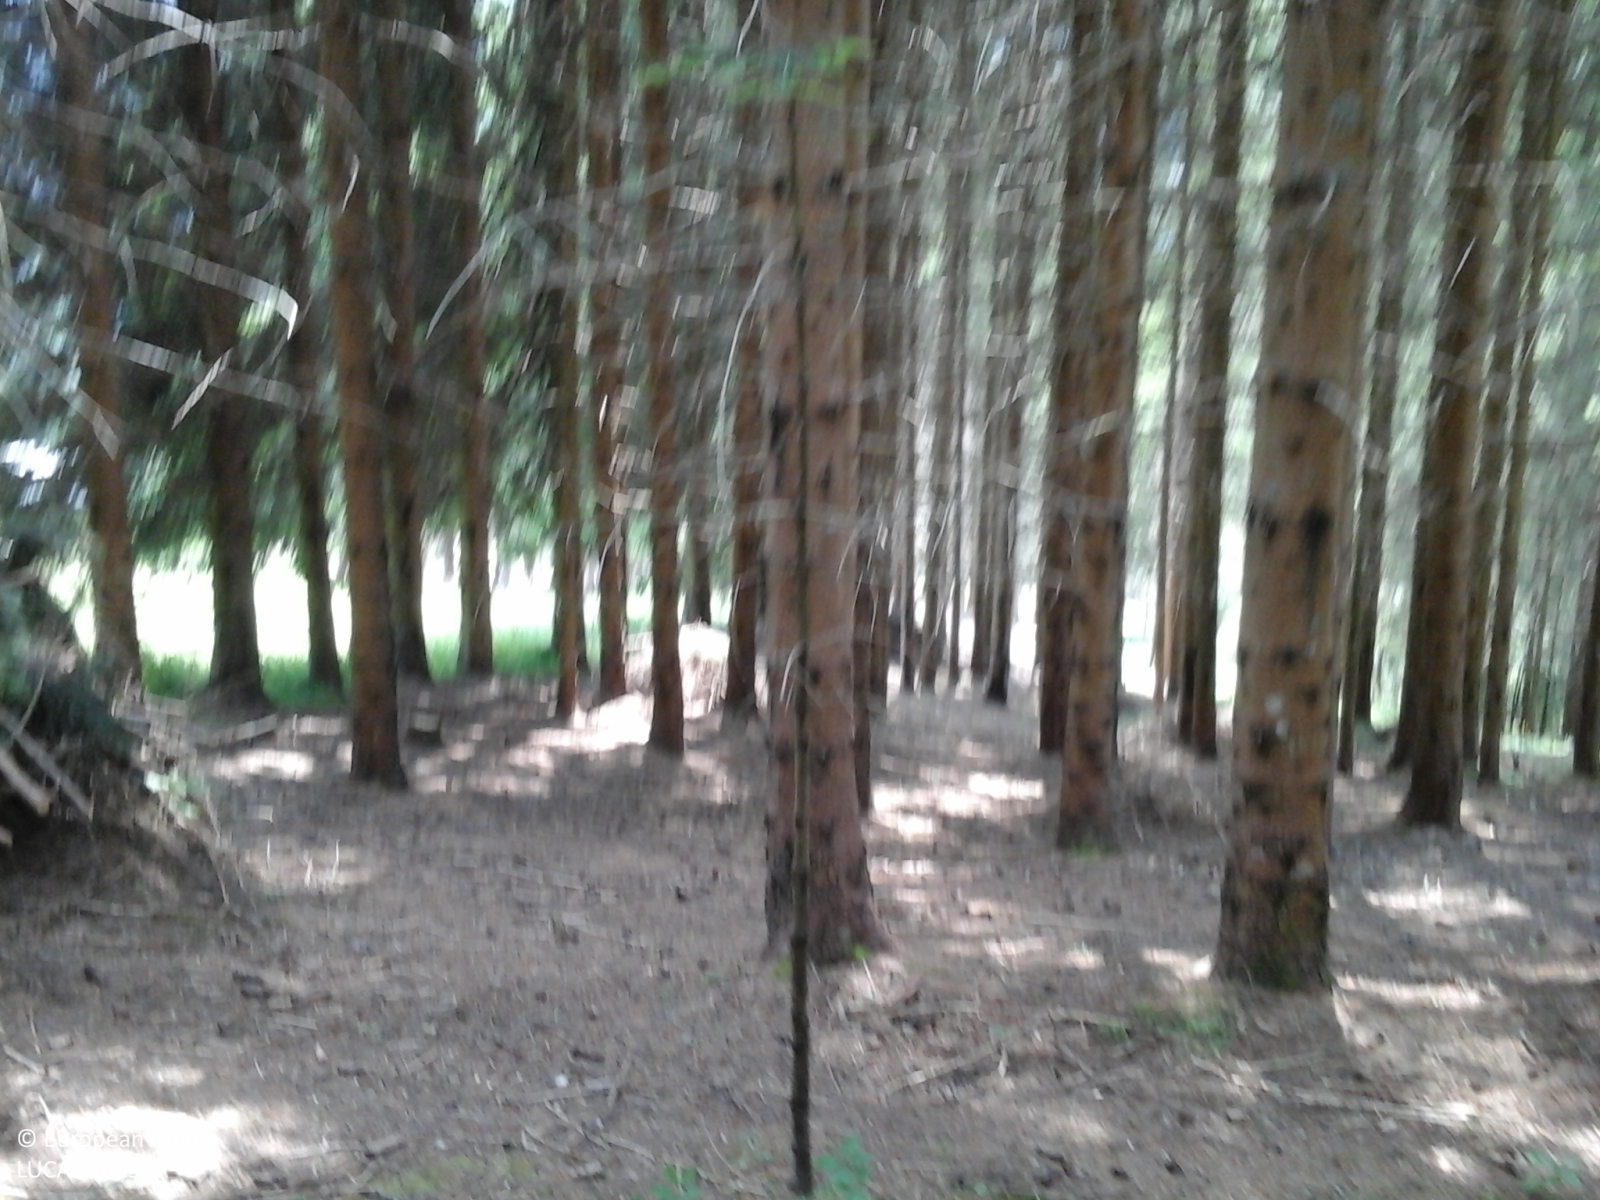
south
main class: Woodland
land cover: Spruce dominated coniferous woodland
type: alpine coniferous forest
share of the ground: > 75 %
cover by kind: coniferous forest trees 95 %, herbaceous plants 5 %
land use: Forestry
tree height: > 5 m
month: June
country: IT
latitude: 46.5701
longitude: 12.6720
